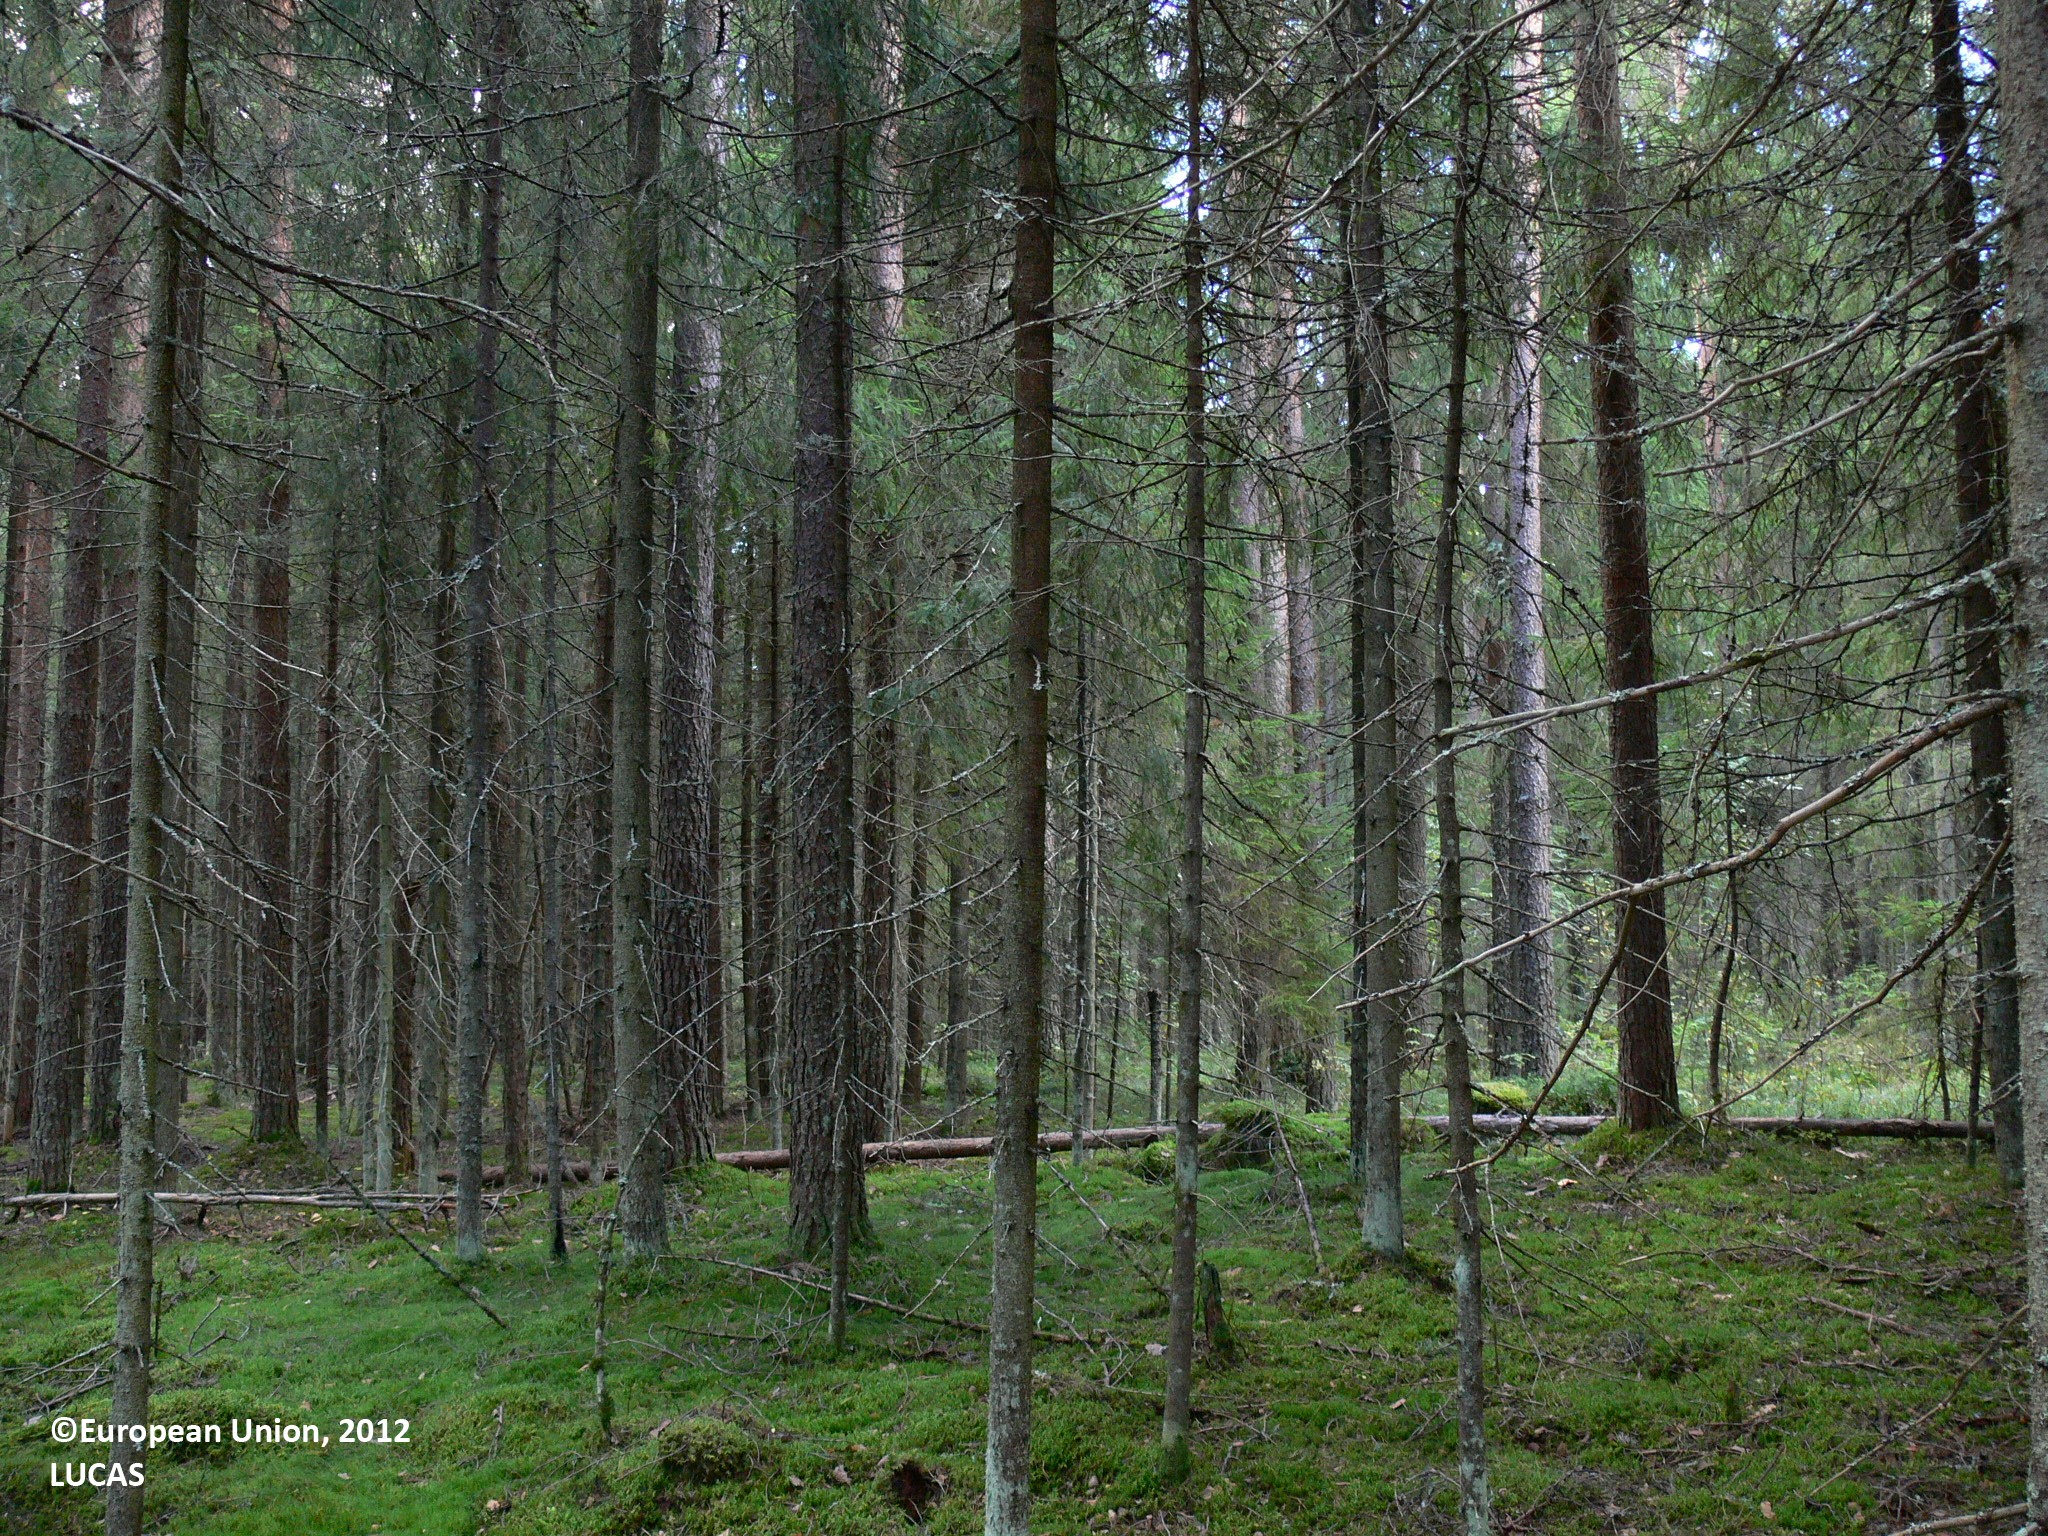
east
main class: Woodland
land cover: Other coniferous woodland
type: boreal forest
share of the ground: > 75 %
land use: Forestry
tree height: > 5 m
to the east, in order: Other coniferous woodland; Other mixed woodland; Other coniferous woodland; Ditches and canals; Pine dominated coniferous woodland; Ditches and canals; Pine dominated mixed woodland; Ditches and canals; Pine dominated mixed woodland
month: August
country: FI
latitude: 61.9783
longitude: 30.2546
